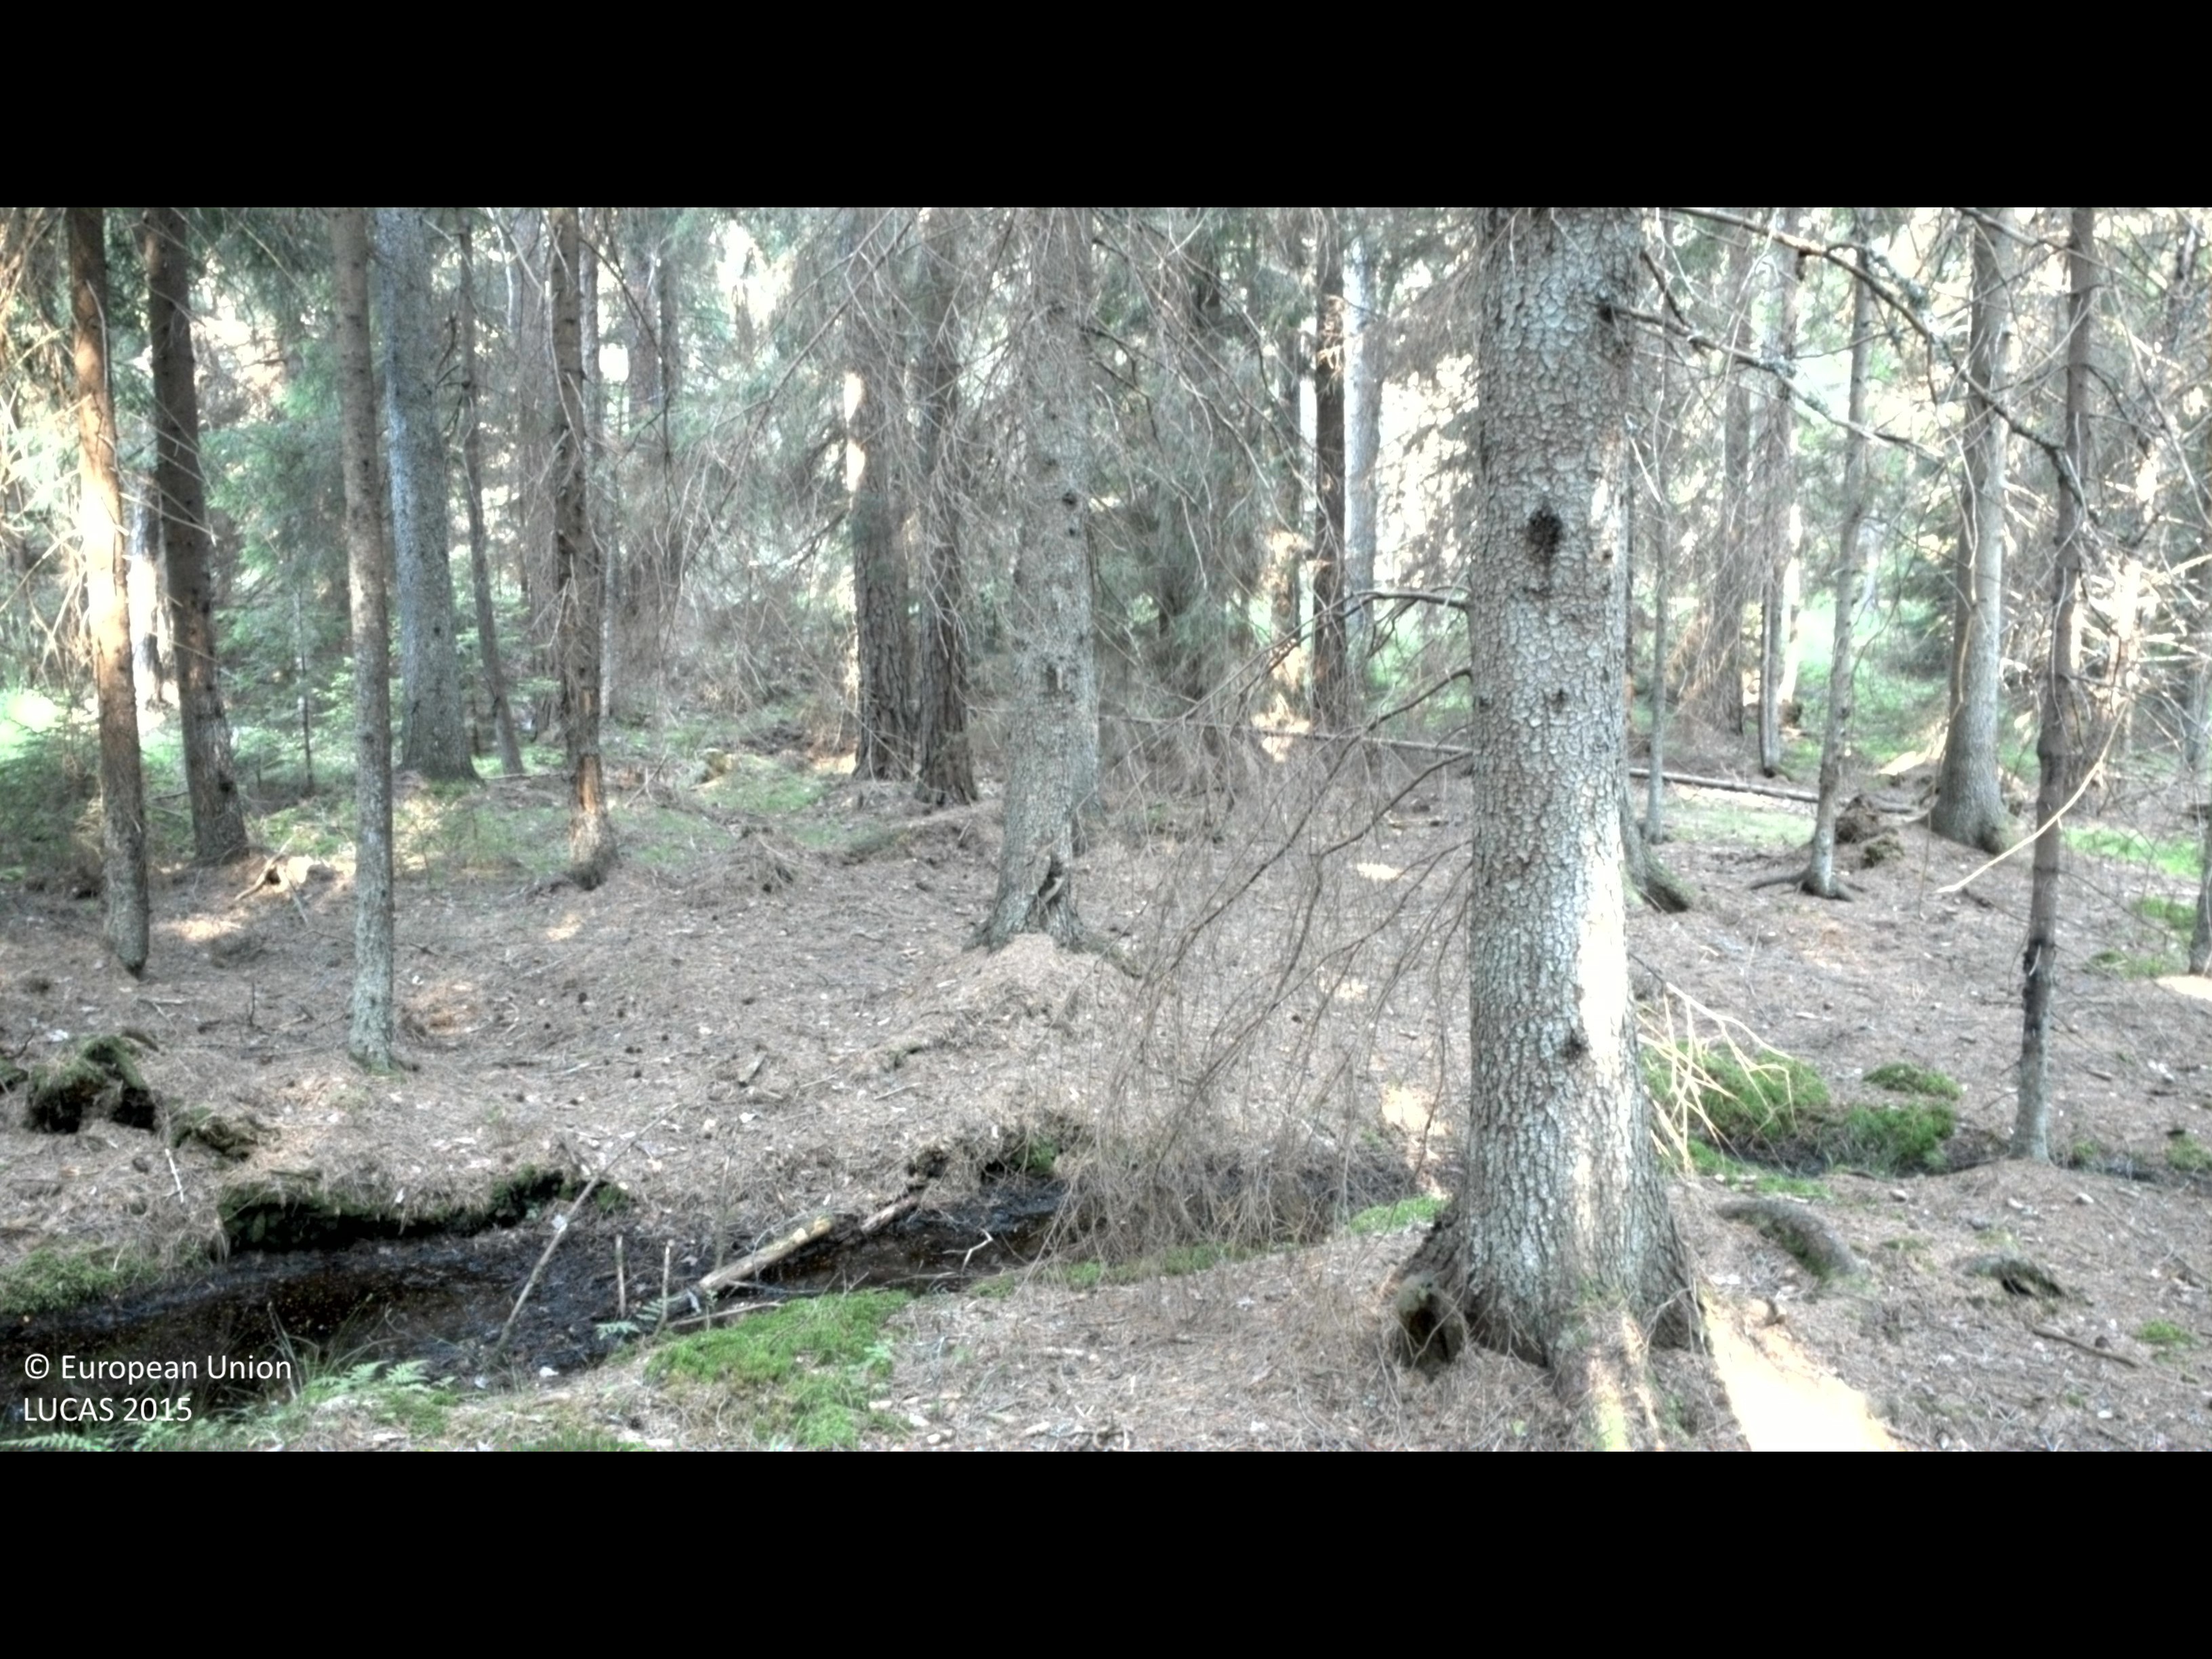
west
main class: Woodland
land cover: Spruce dominated coniferous woodland
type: boreal forest
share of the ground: > 75 %
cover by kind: coniferous forest trees 85 %, shrubs 10 %, lichens and mosses 5 %
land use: Forestry
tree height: > 5 m
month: July
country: SE
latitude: 58.2547
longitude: 16.6260
